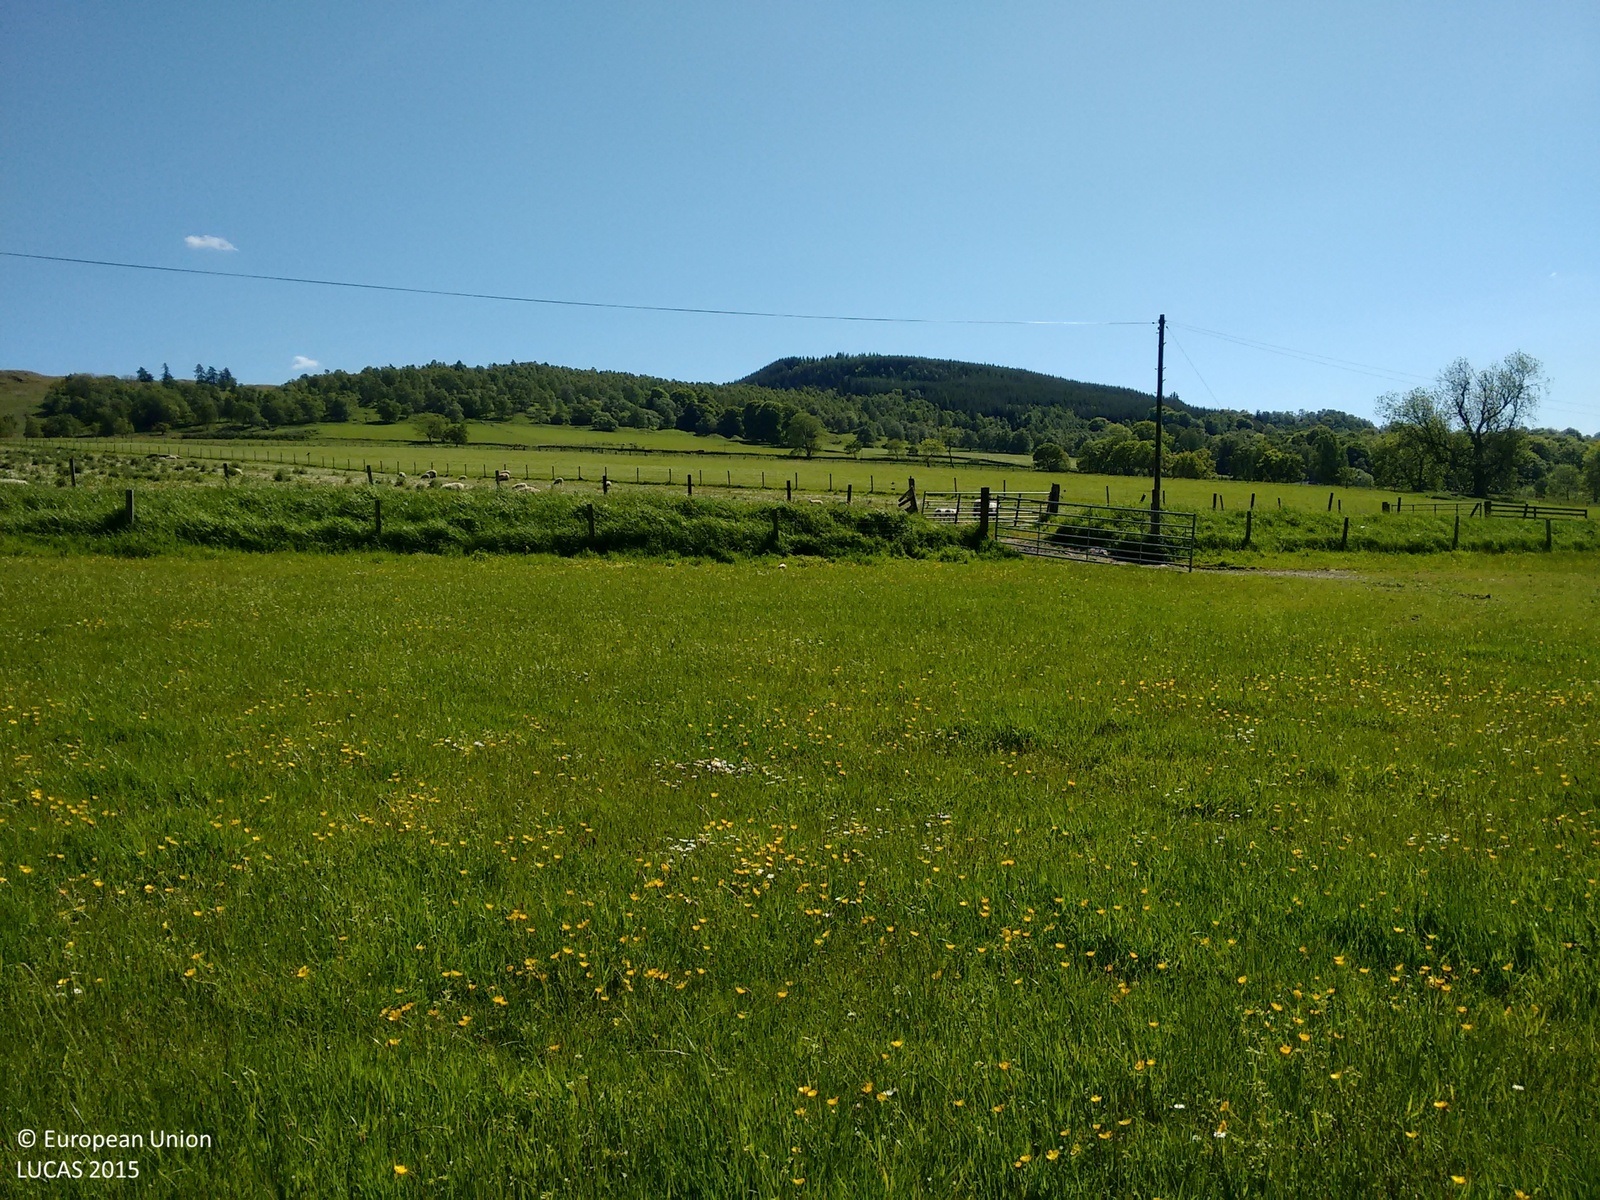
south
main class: Grassland
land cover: Grassland without tree/shrub cover
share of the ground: > 75 %
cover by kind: herbaceous plants 100 %
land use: Agriculture (excluding fallow land and kitchen gardens)
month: June
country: GB
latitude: 56.6195
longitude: -3.8522
